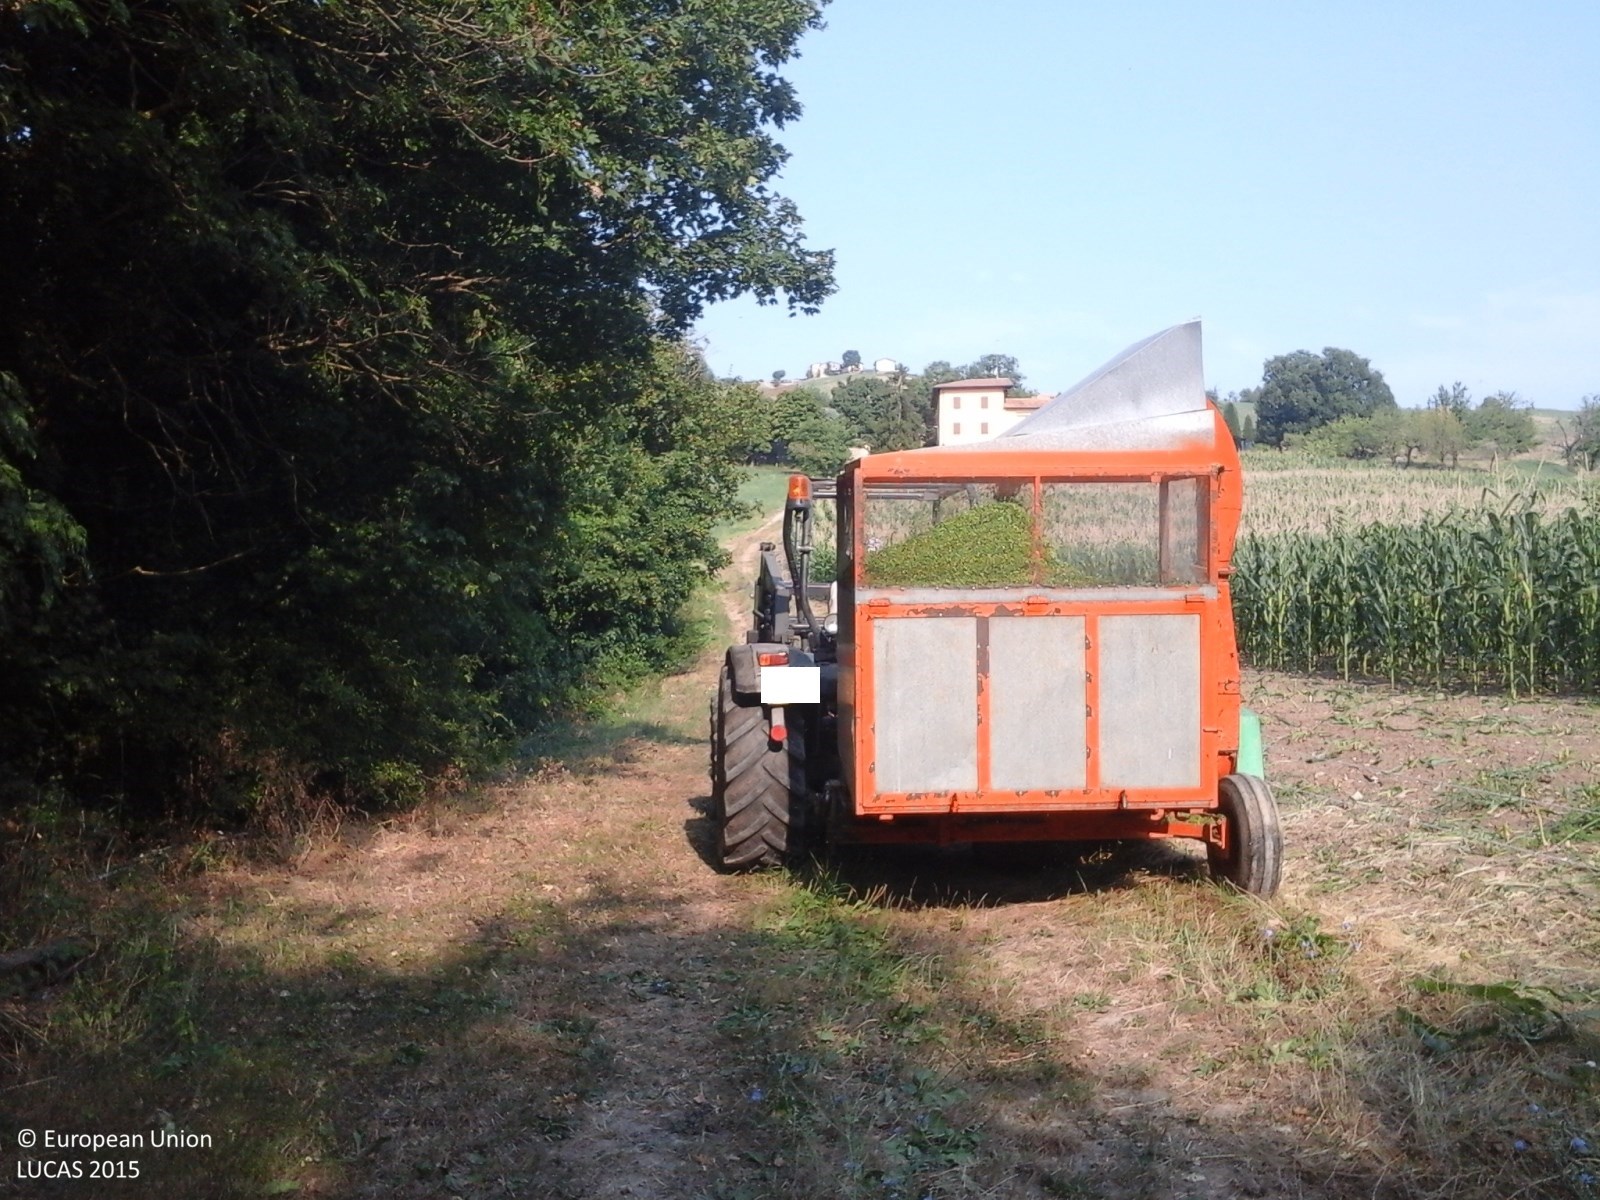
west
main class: Cropland
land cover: Maize
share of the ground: > 75 %
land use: Agriculture (excluding fallow land and kitchen gardens)
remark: Harvested field
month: July
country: IT
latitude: 44.3648
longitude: 10.8889
